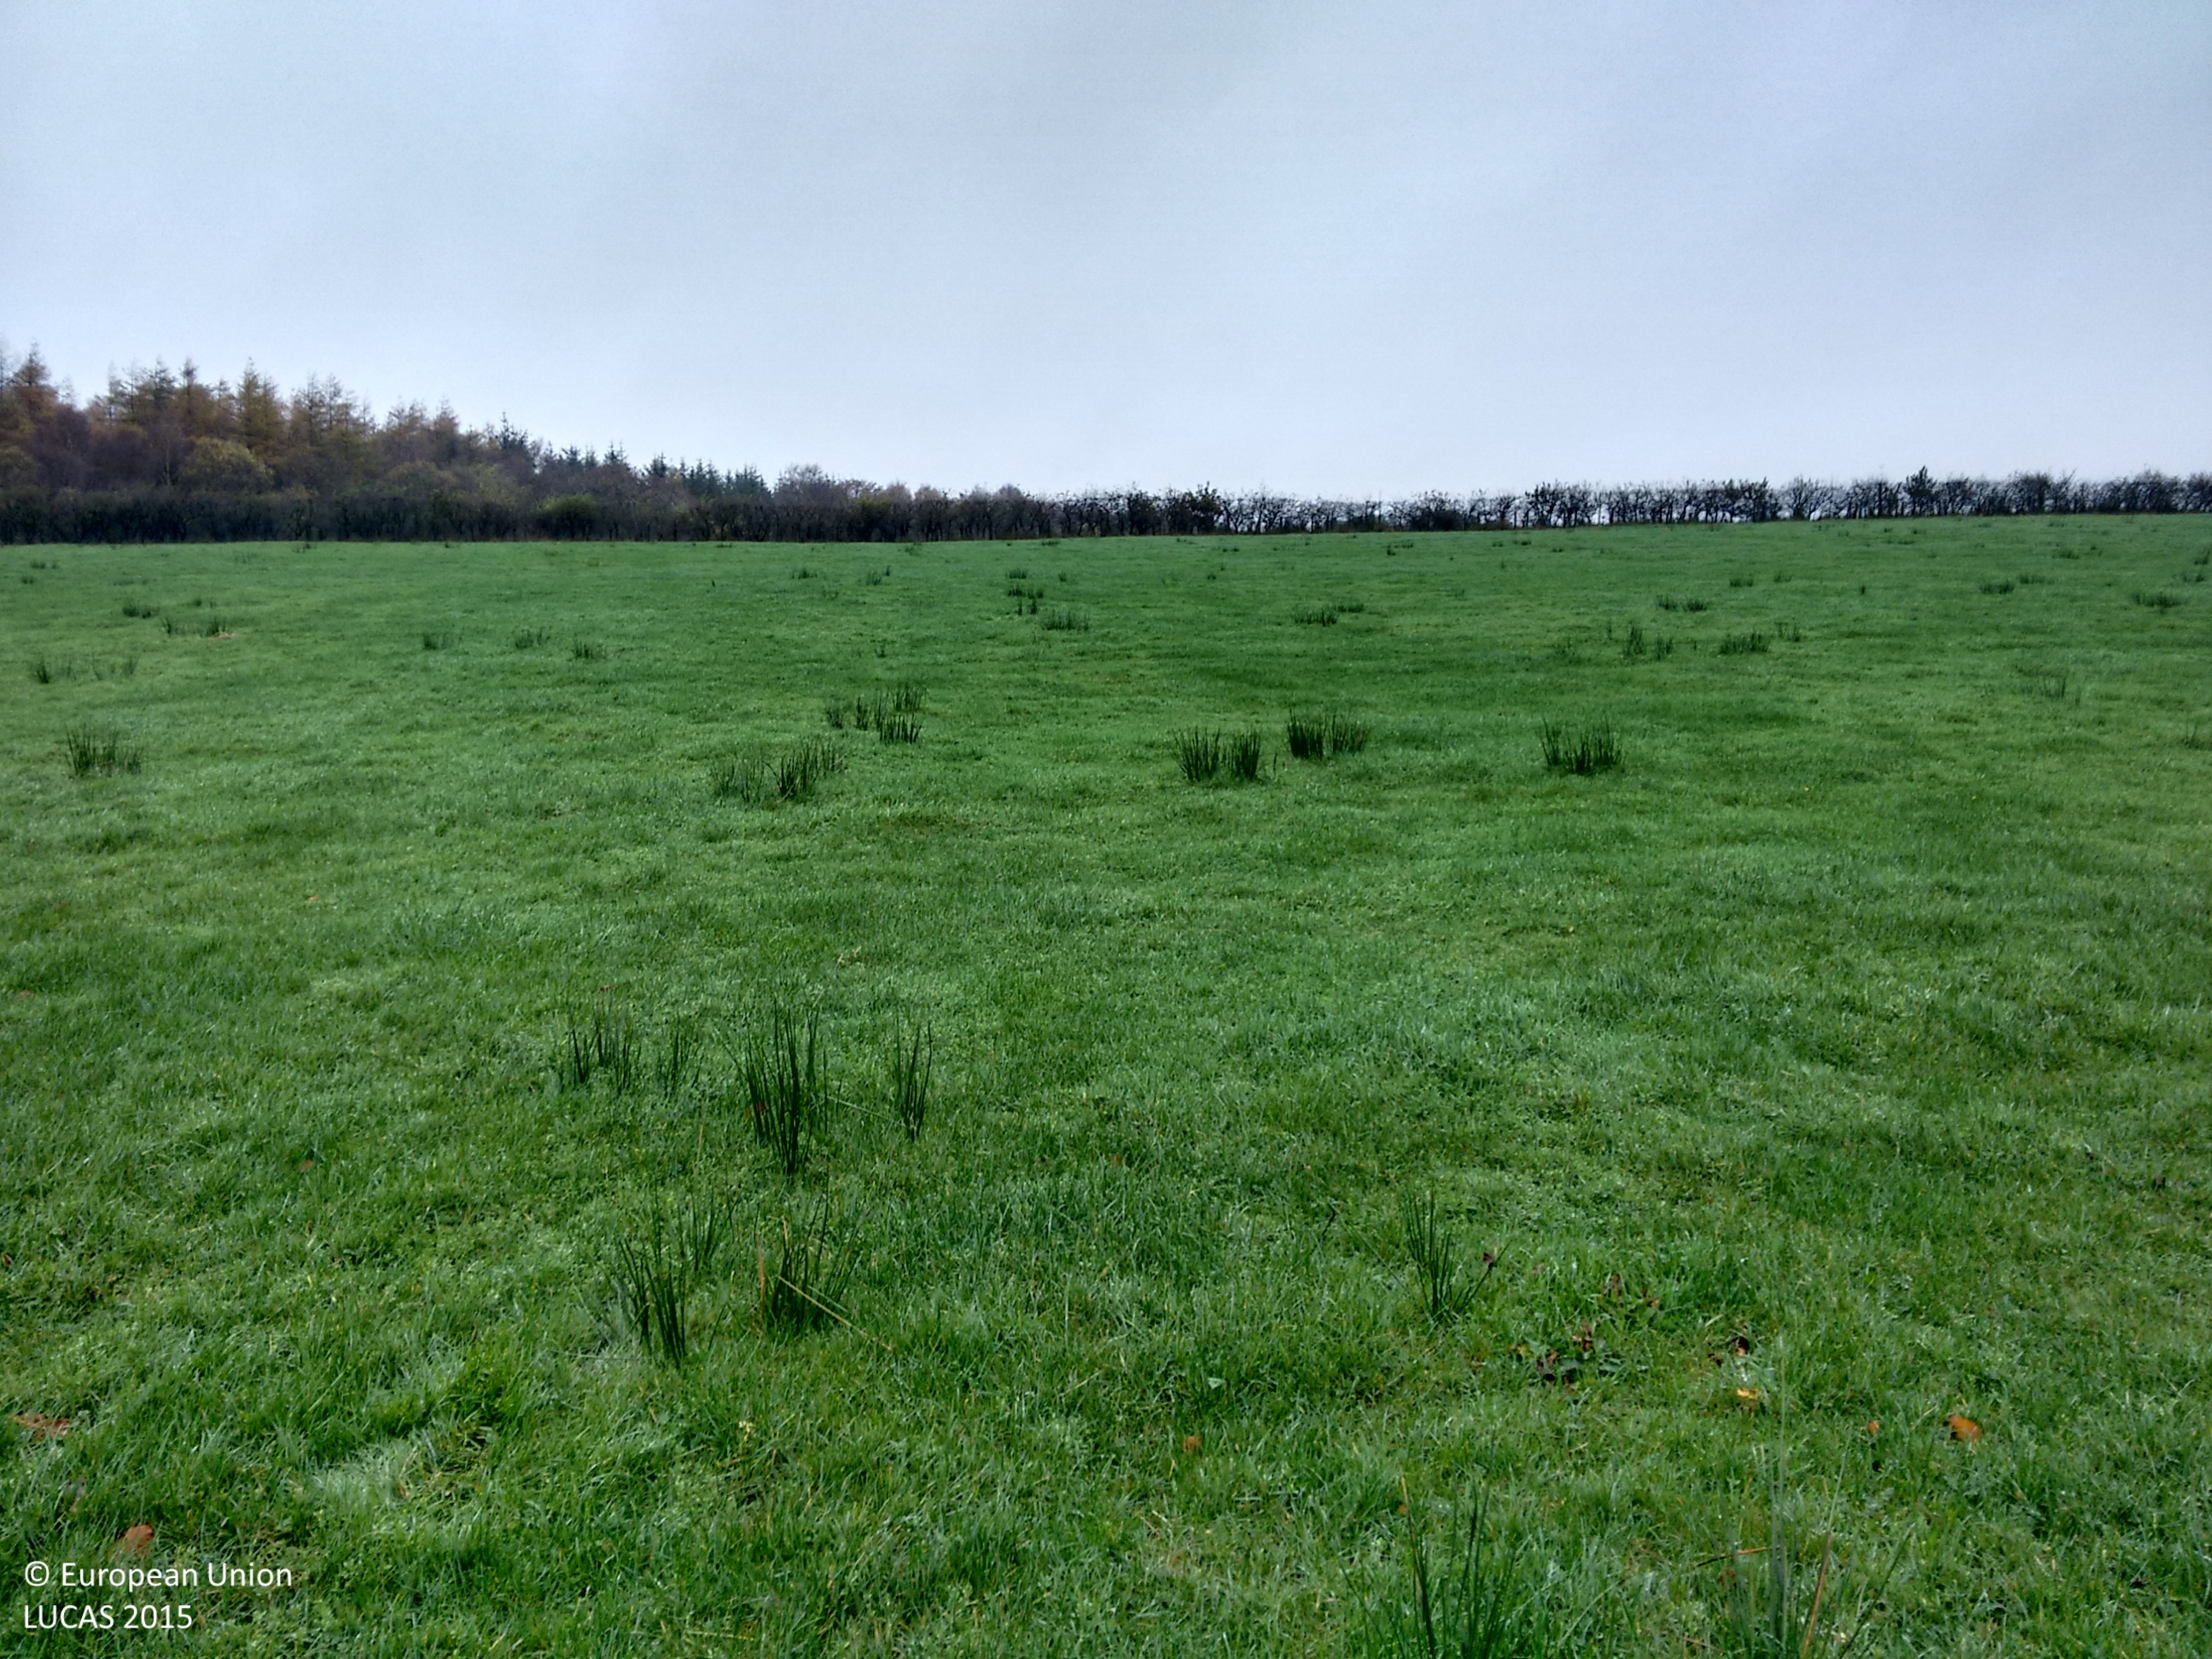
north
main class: Grassland
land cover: Grassland without tree/shrub cover
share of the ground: > 75 %
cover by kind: herbaceous plants 100 %
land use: Agriculture (excluding fallow land and kitchen gardens)
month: November
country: GB
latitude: 54.5299
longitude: -3.4159
